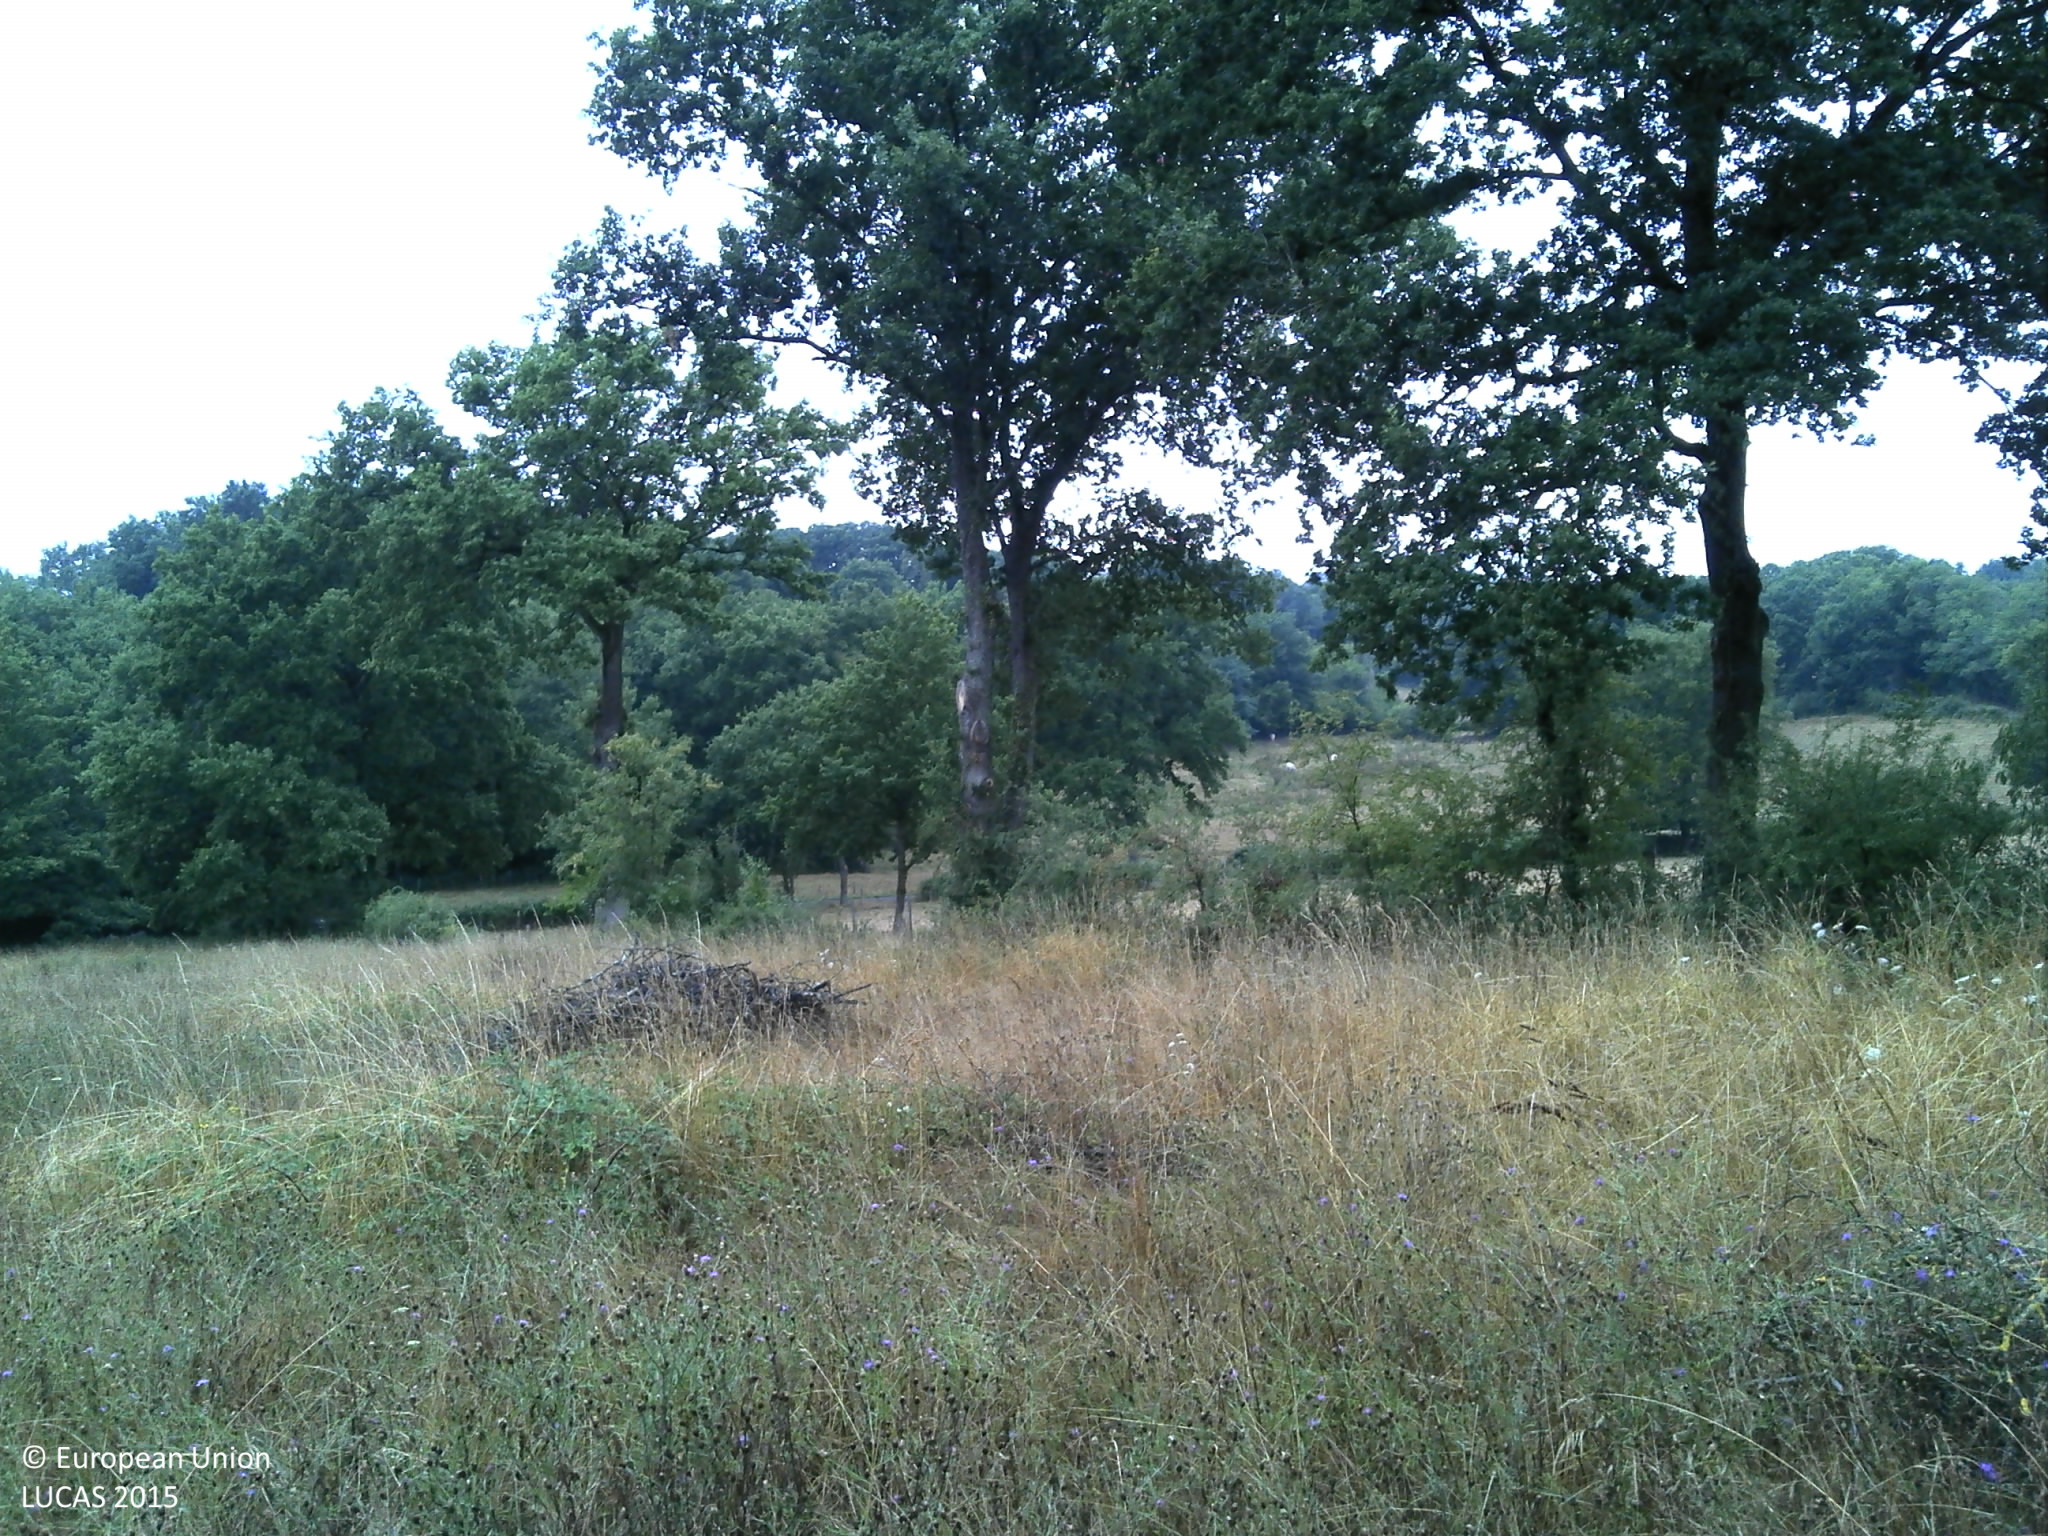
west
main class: Grassland
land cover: Grassland without tree/shrub cover
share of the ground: > 75 %
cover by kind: herbaceous plants 100 %
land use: Agriculture (excluding fallow land and kitchen gardens)
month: August
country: FR
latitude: 46.1679
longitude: 4.0564
